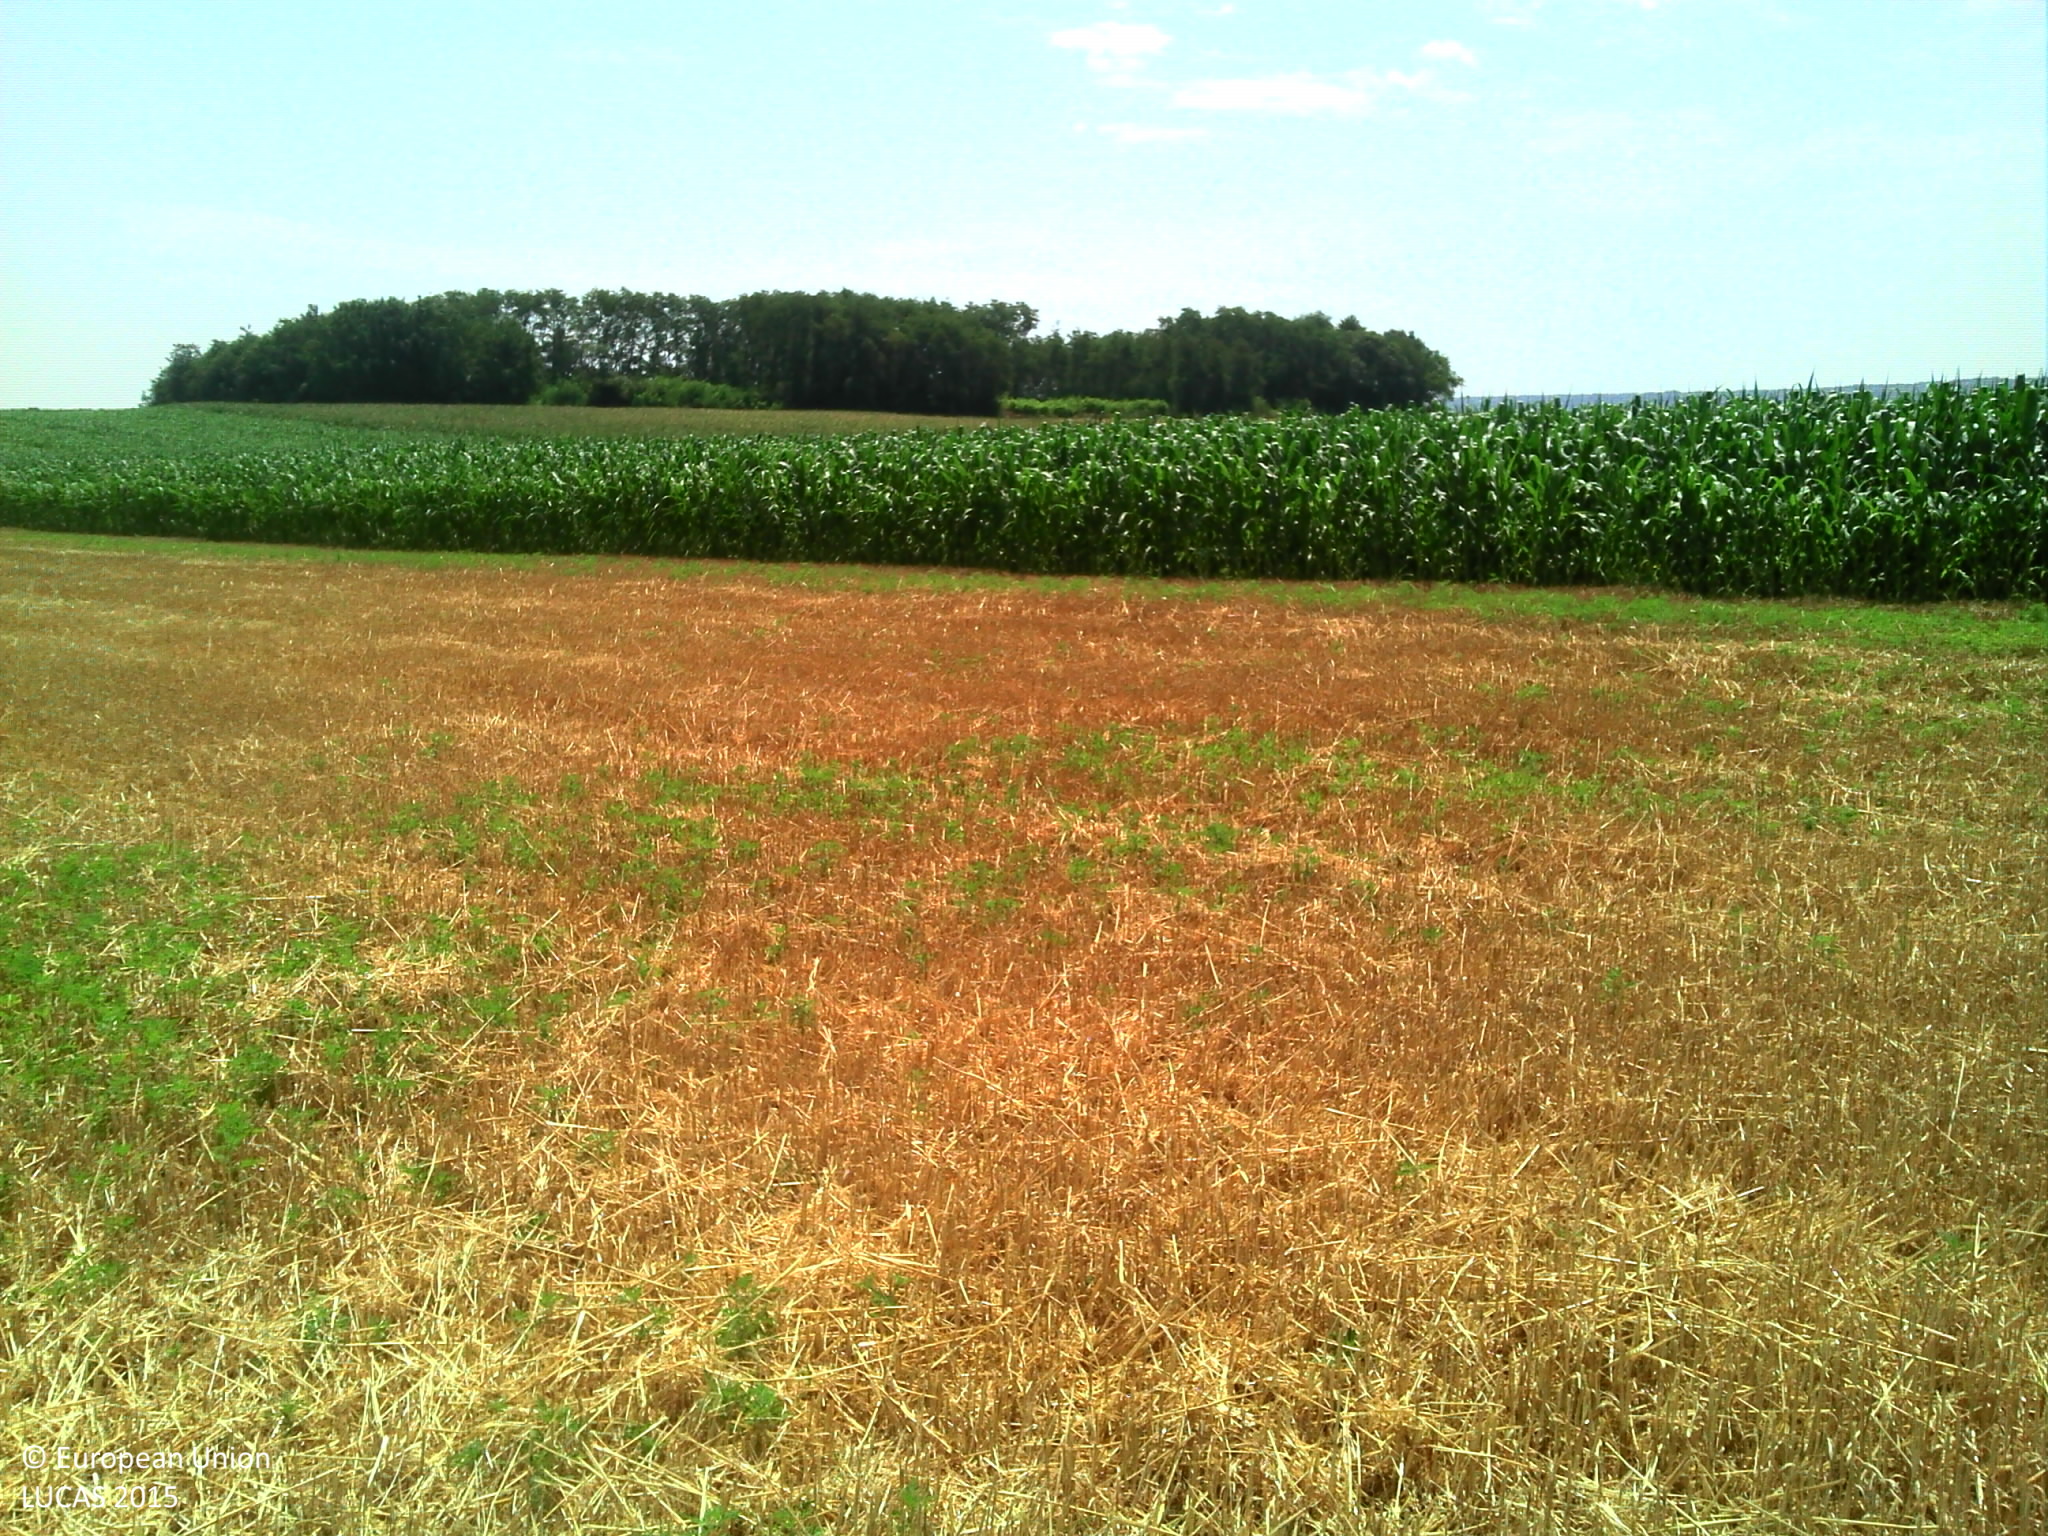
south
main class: Cropland
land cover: Durum wheat
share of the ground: < 10 %
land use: Agriculture (excluding fallow land and kitchen gardens)
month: July
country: FR
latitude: 45.3565
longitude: 5.1412
